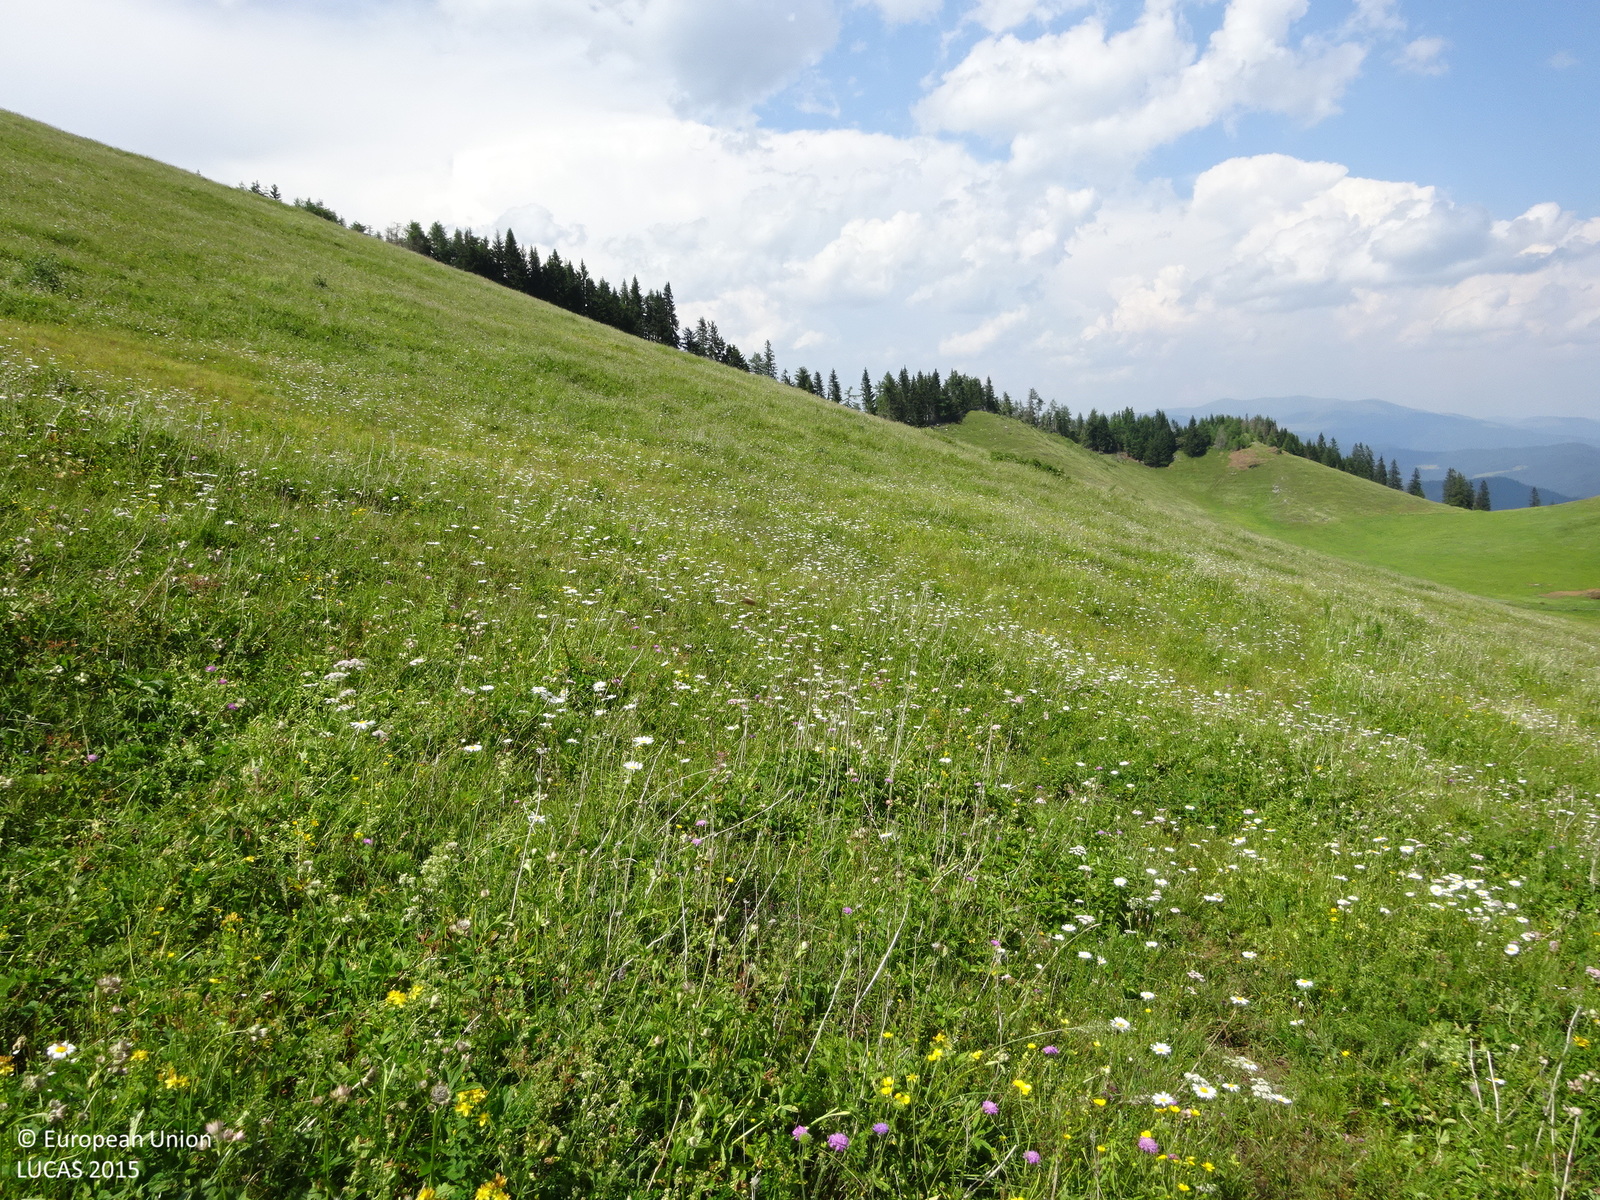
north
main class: Grassland
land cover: Grassland without tree/shrub cover
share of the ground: > 75 %
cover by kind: herbaceous plants 100 %
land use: Agriculture (excluding fallow land and kitchen gardens)
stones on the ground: < 10 %
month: July
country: AT
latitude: 47.0851
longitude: 14.9385
